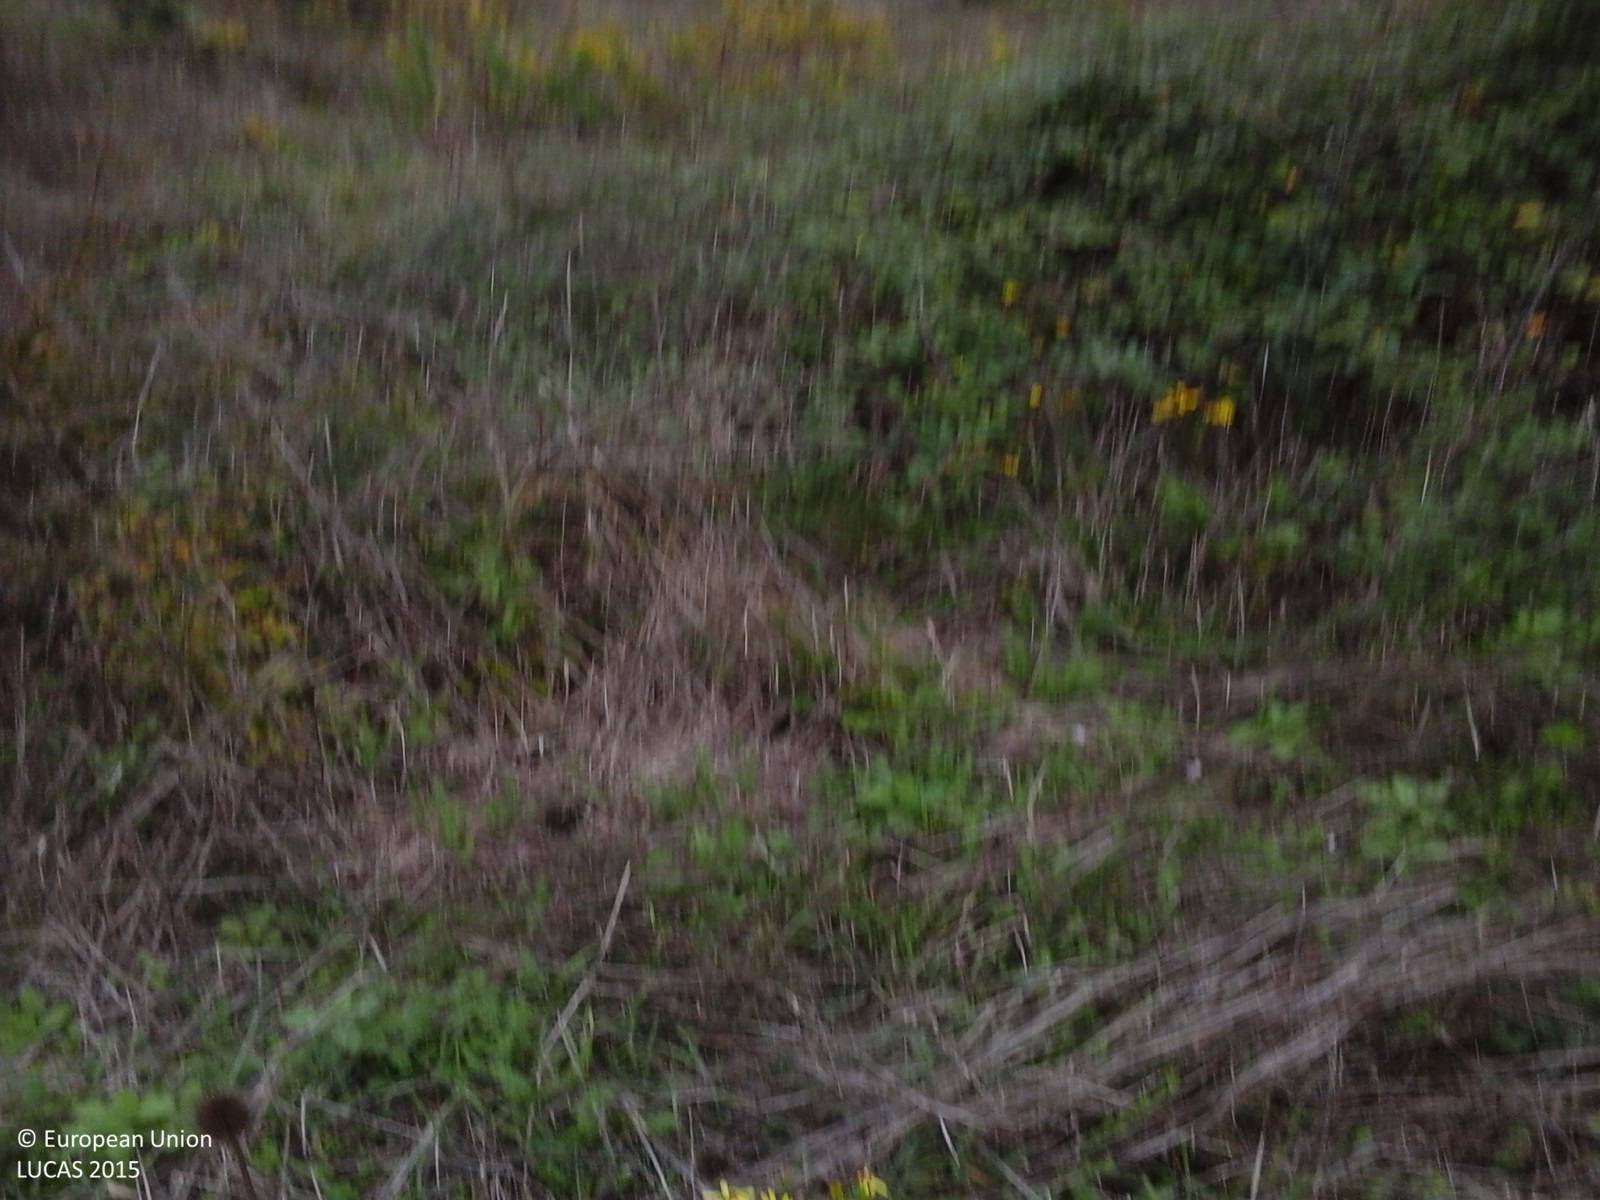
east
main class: Shrubland
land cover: Shrubland without tree cover
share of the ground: > 75 %
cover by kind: shrubs 90 %, herbaceous plants 10 %
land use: Abandoned areas
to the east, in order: Shrubland without tree cover; Broadleaved woodland; Inland fresh running water; Broadleaved woodland; Maize
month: October
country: IT
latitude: 43.3098
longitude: 11.5859
